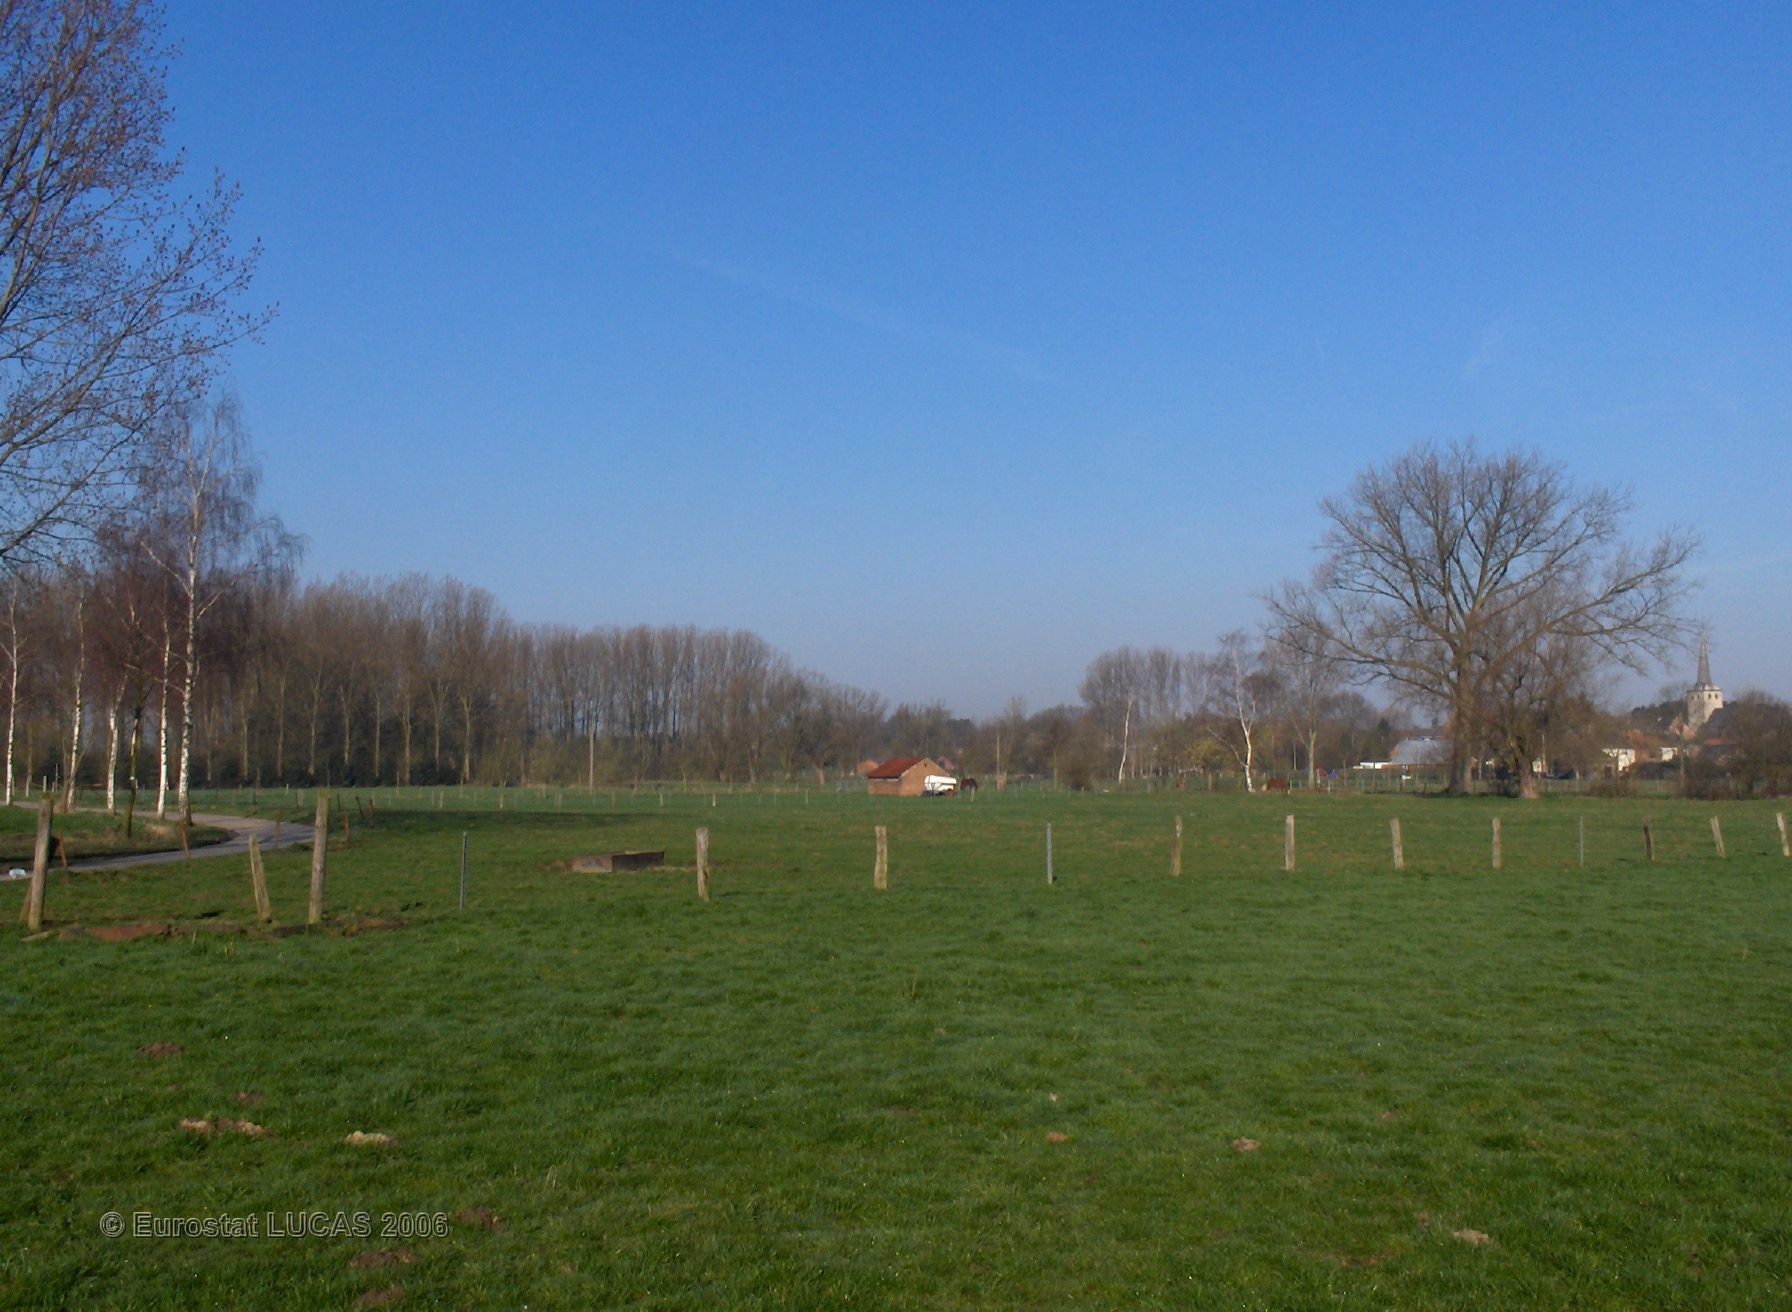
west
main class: Grassland
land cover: Grassland without tree/shrub cover
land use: Agriculture (excluding fallow land and kitchen gardens)
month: April
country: BE
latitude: 50.5013
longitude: 4.4832
